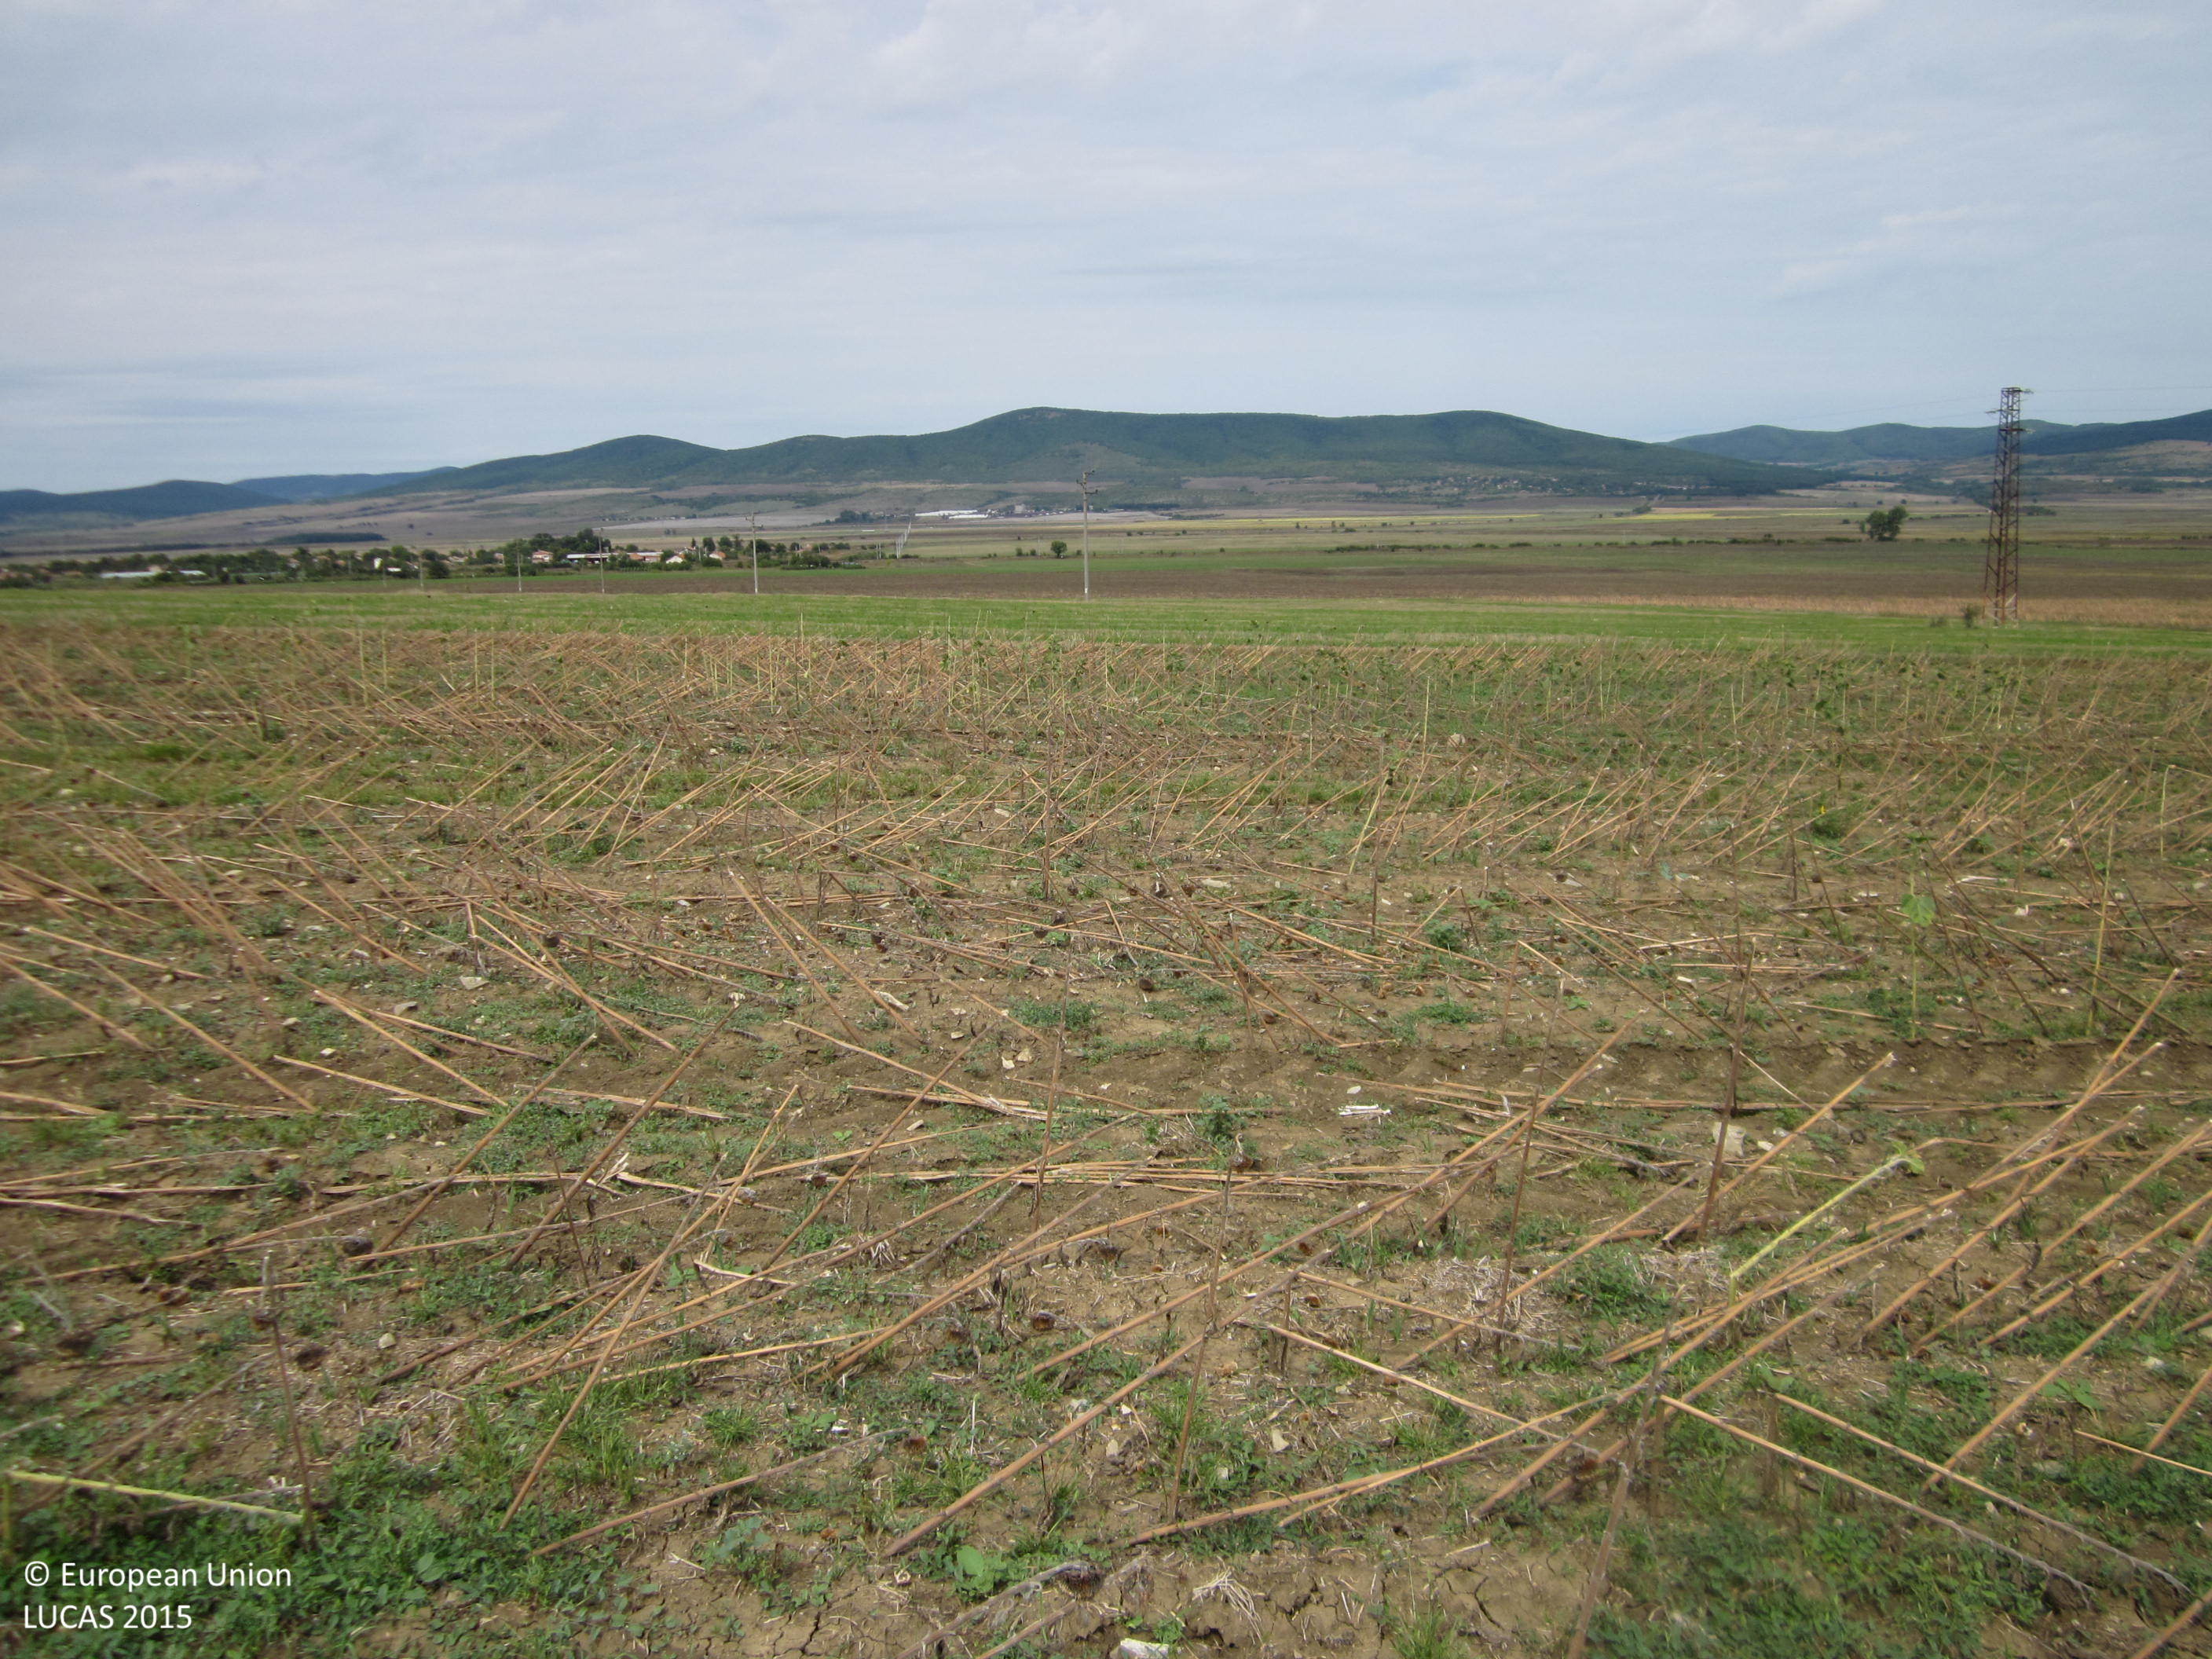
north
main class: Cropland
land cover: Sunflower
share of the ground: 50 - 75 %
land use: Agriculture (excluding fallow land and kitchen gardens)
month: September
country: BG
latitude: 42.6896
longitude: 27.0371
